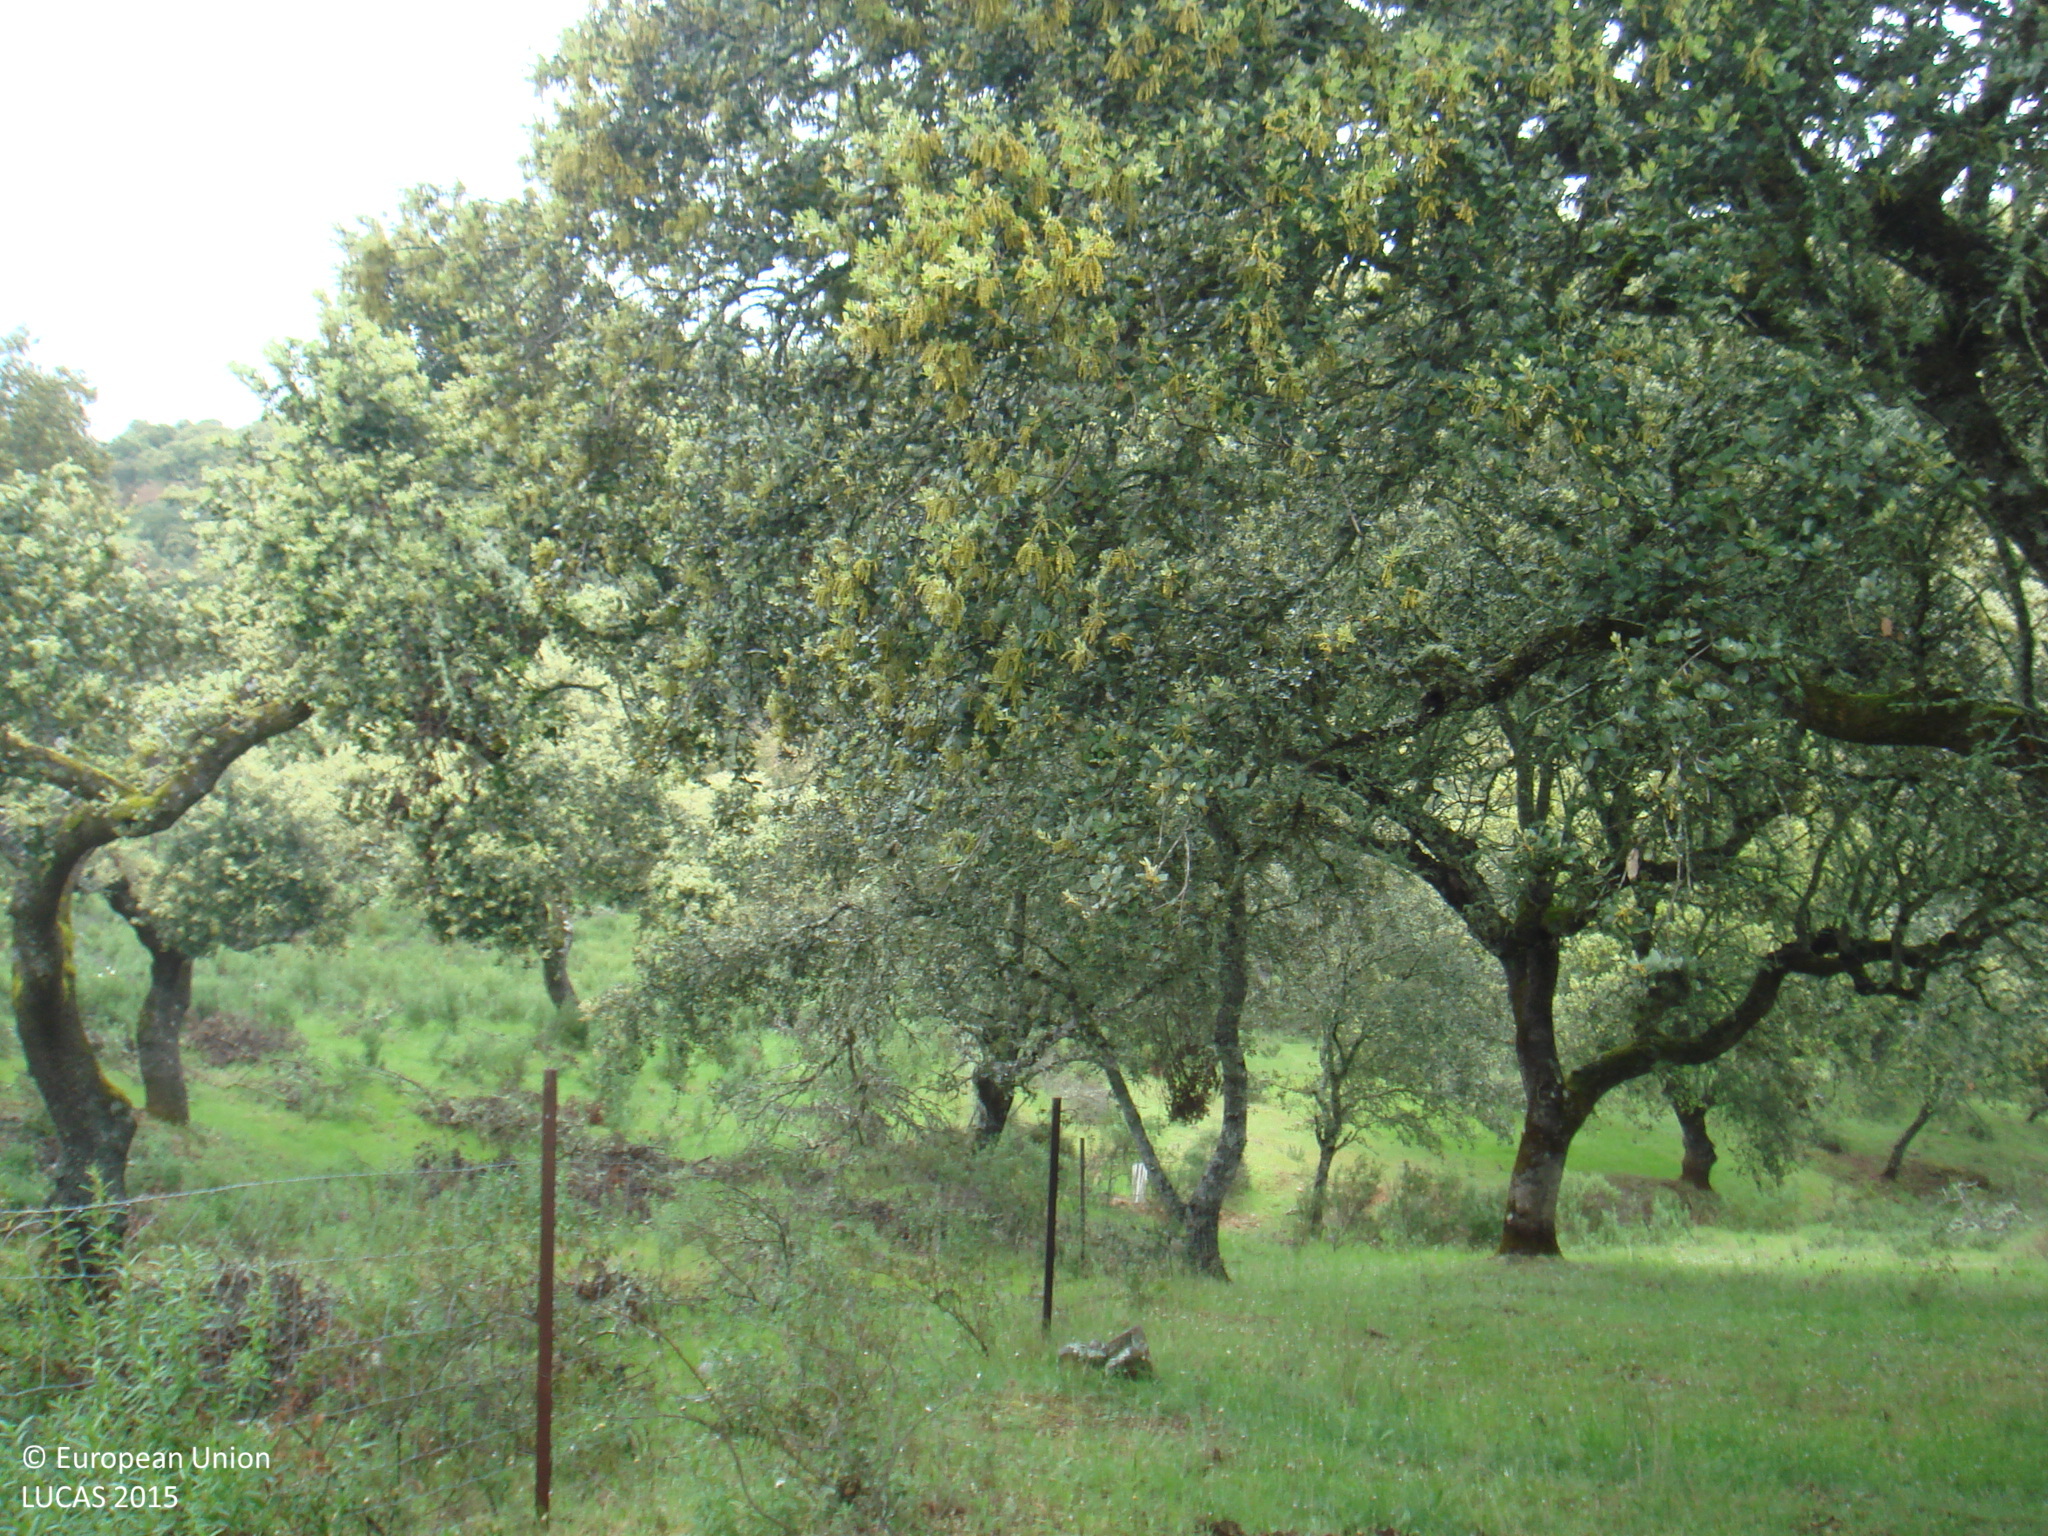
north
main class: Woodland
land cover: Broadleaved woodland
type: broadleaved evergreen forest
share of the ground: 50 - 75 %
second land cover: Spontaneously vegetated surfaces
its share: 50 - 75 %
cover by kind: broadleaved forest trees 60 %, herbaceous plants 30 %, shrubs 10 %
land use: Forestry
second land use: Agriculture (excluding fallow land and kitchen gardens)
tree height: > 5 m
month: April
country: ES
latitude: 38.1925
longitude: -5.3159
